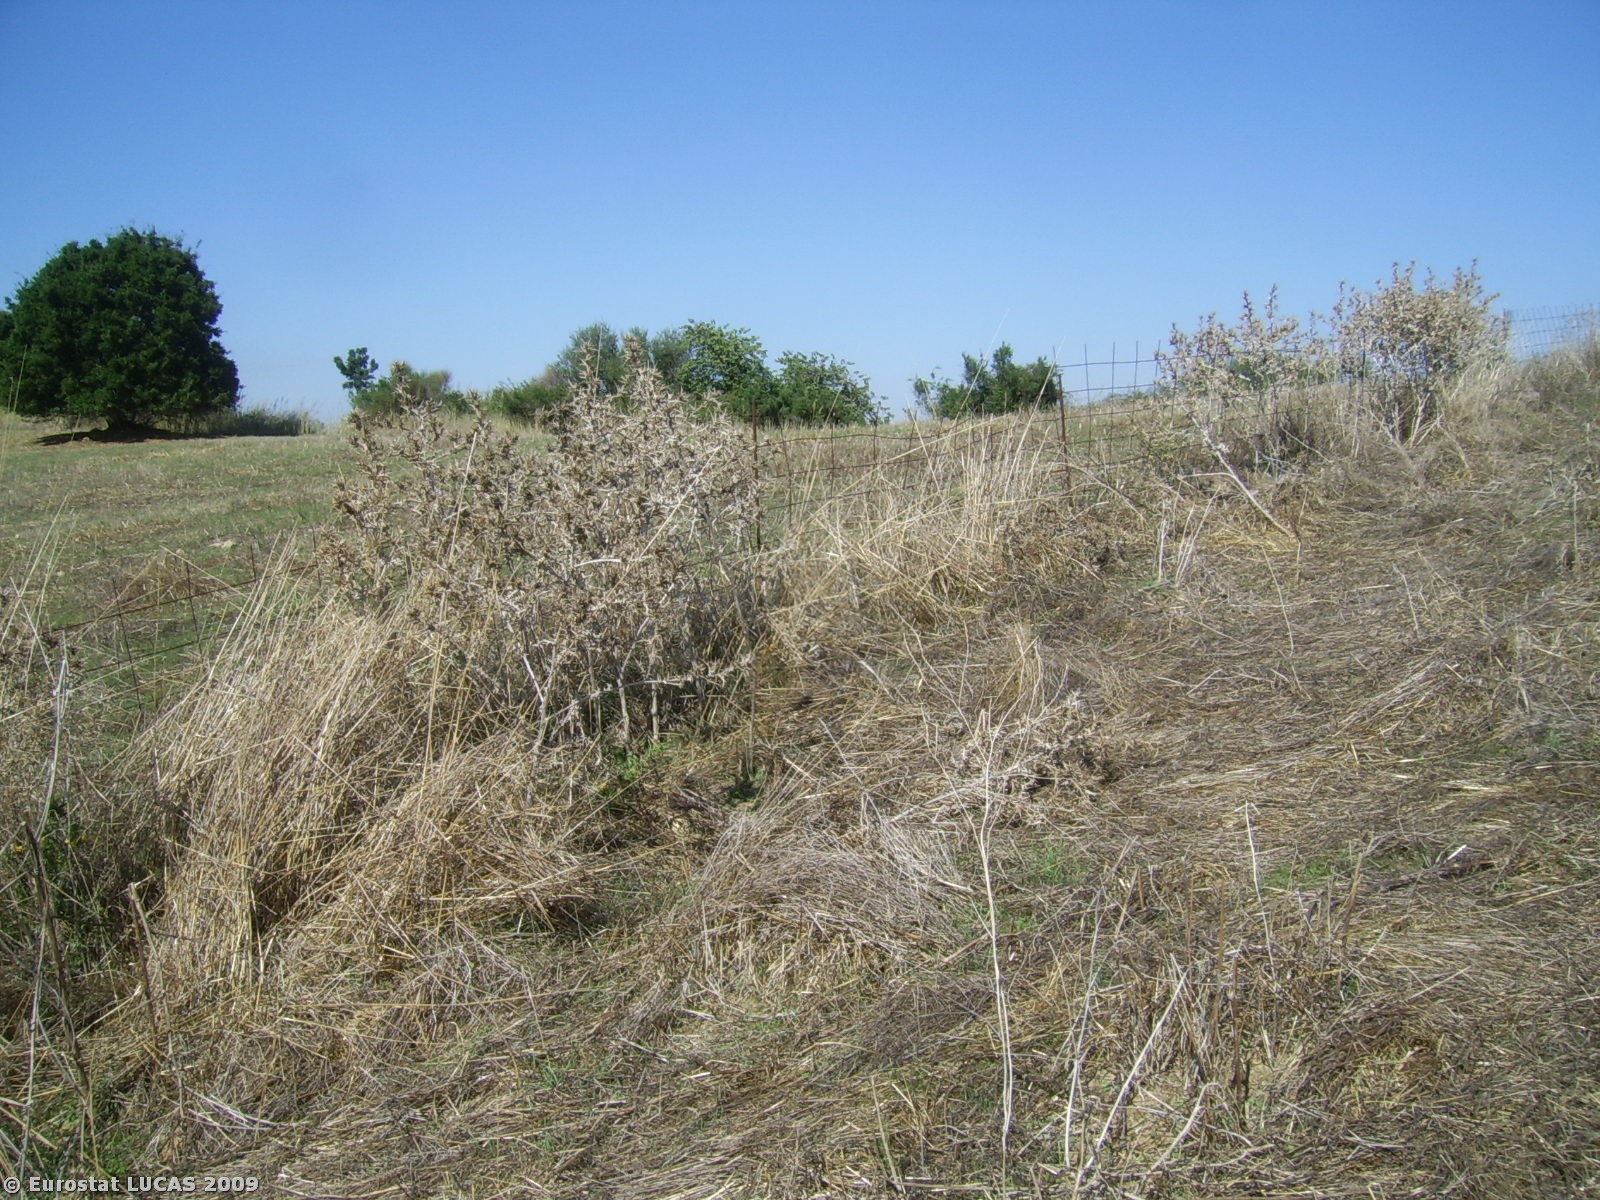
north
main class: Grassland
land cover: Grassland without tree/shrub cover
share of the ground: > 75 %
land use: Agriculture (excluding fallow land and kitchen gardens)
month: October
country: GR
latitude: 37.9408
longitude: 21.3746
